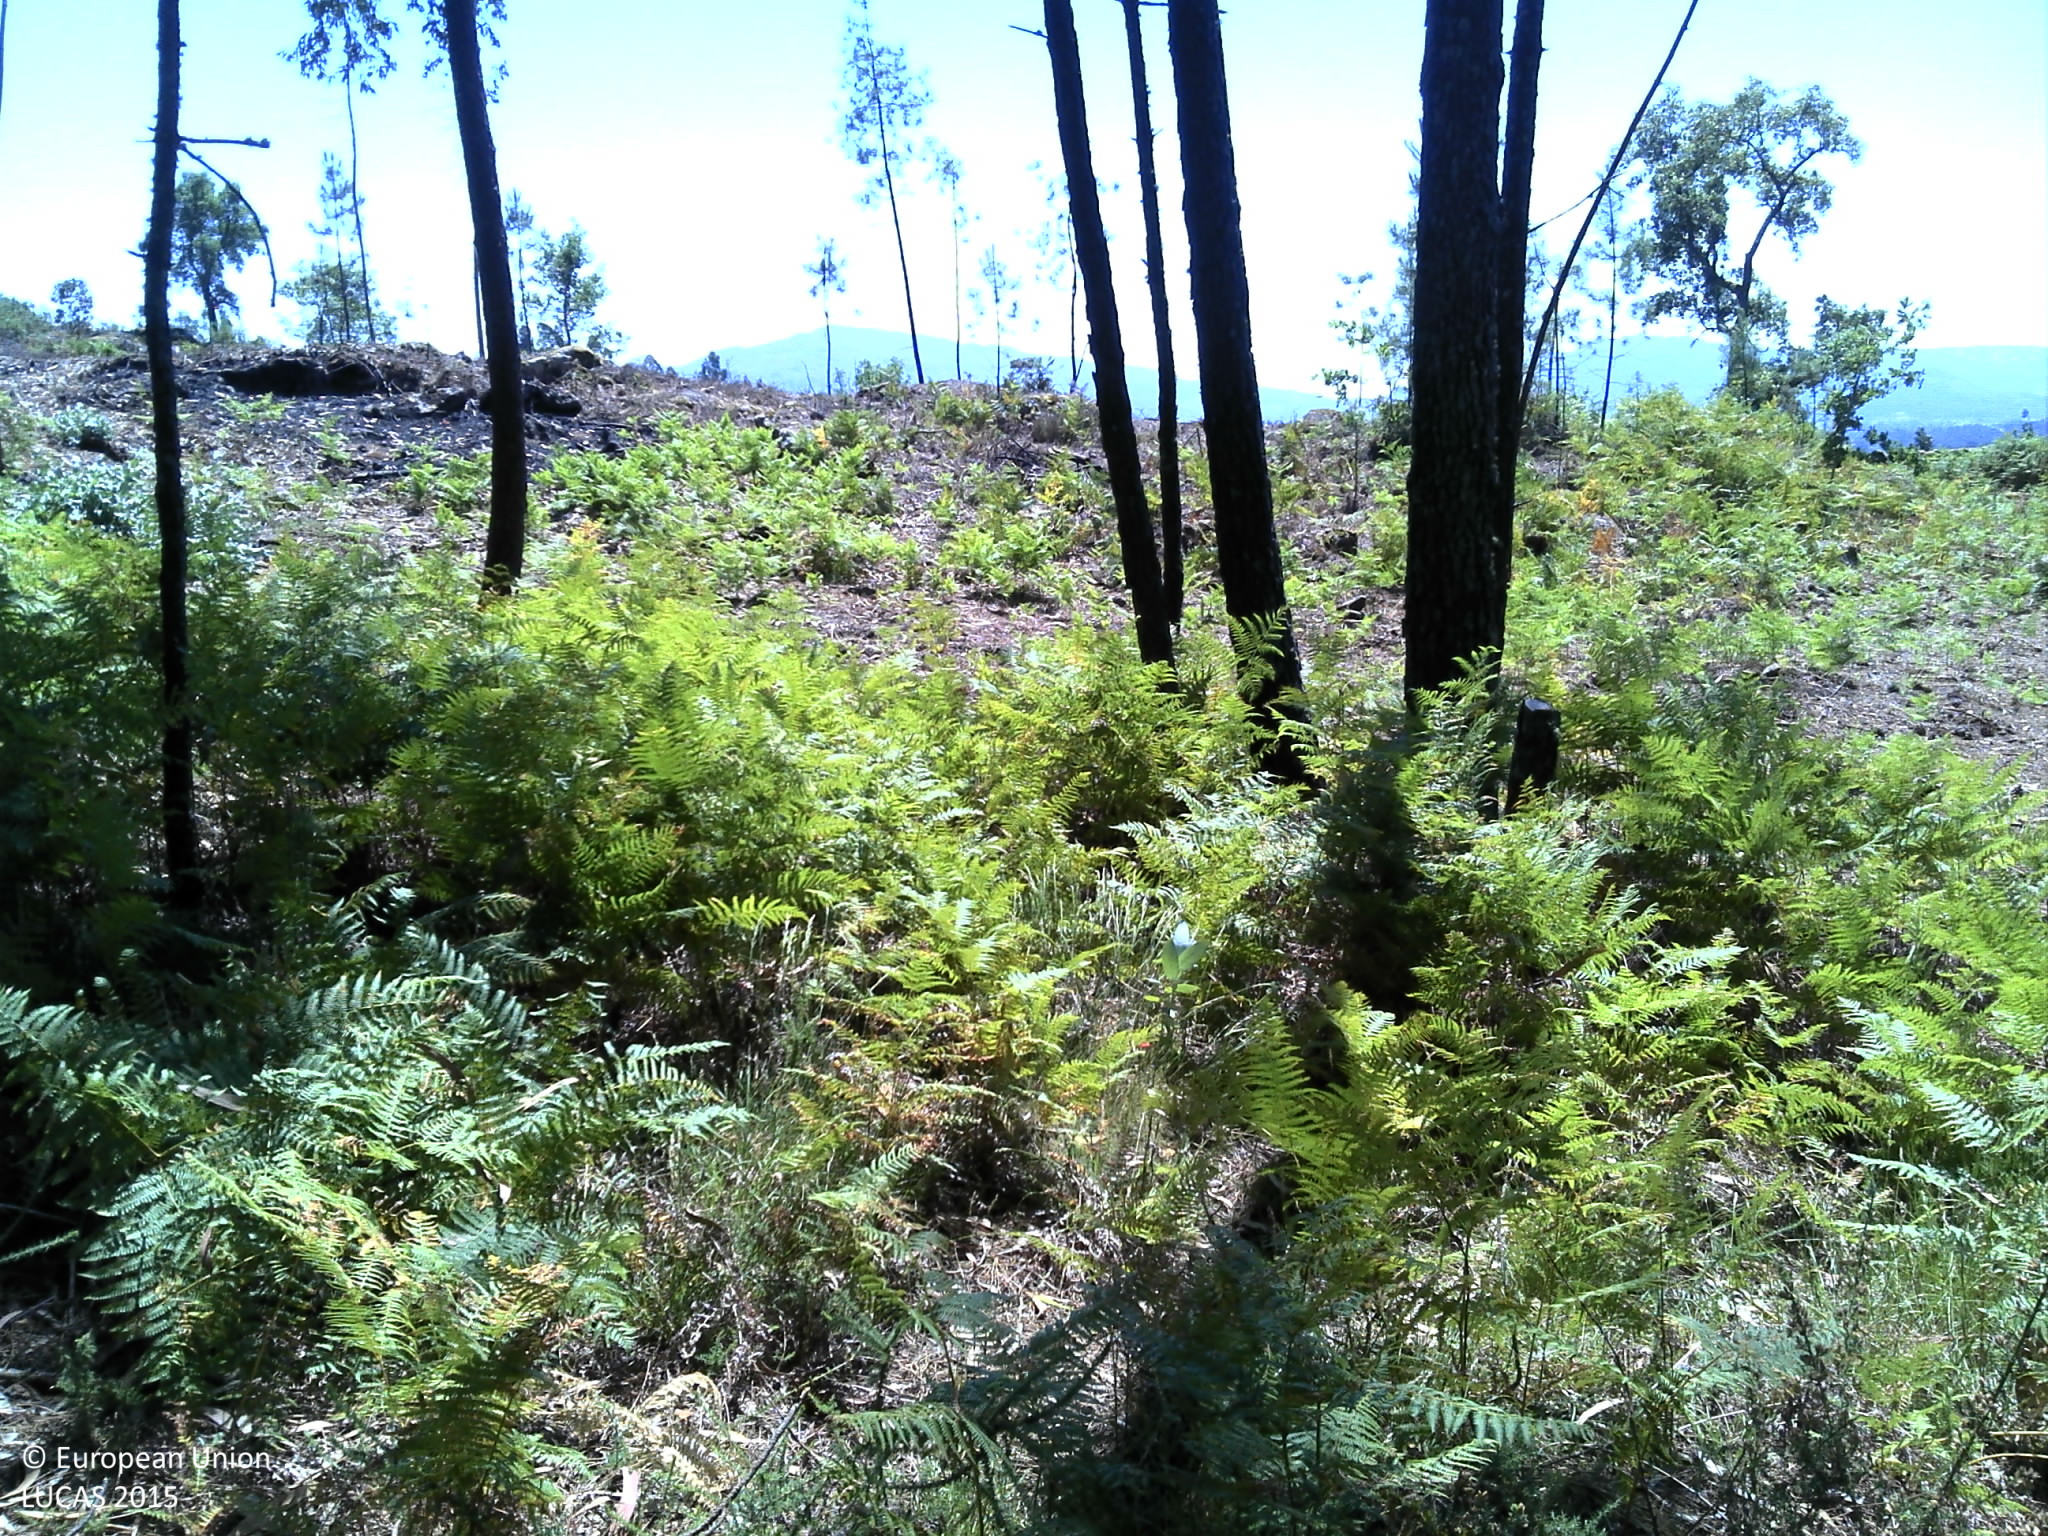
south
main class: Woodland
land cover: Pine dominated mixed woodland
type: coniferous forest of the mediterranean region
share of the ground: 50 - 75 %
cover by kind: coniferous forest trees 75 %, broadleaved forest trees 25 %
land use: Forestry
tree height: > 5 m
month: May
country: PT
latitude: 41.7935
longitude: -8.6363
